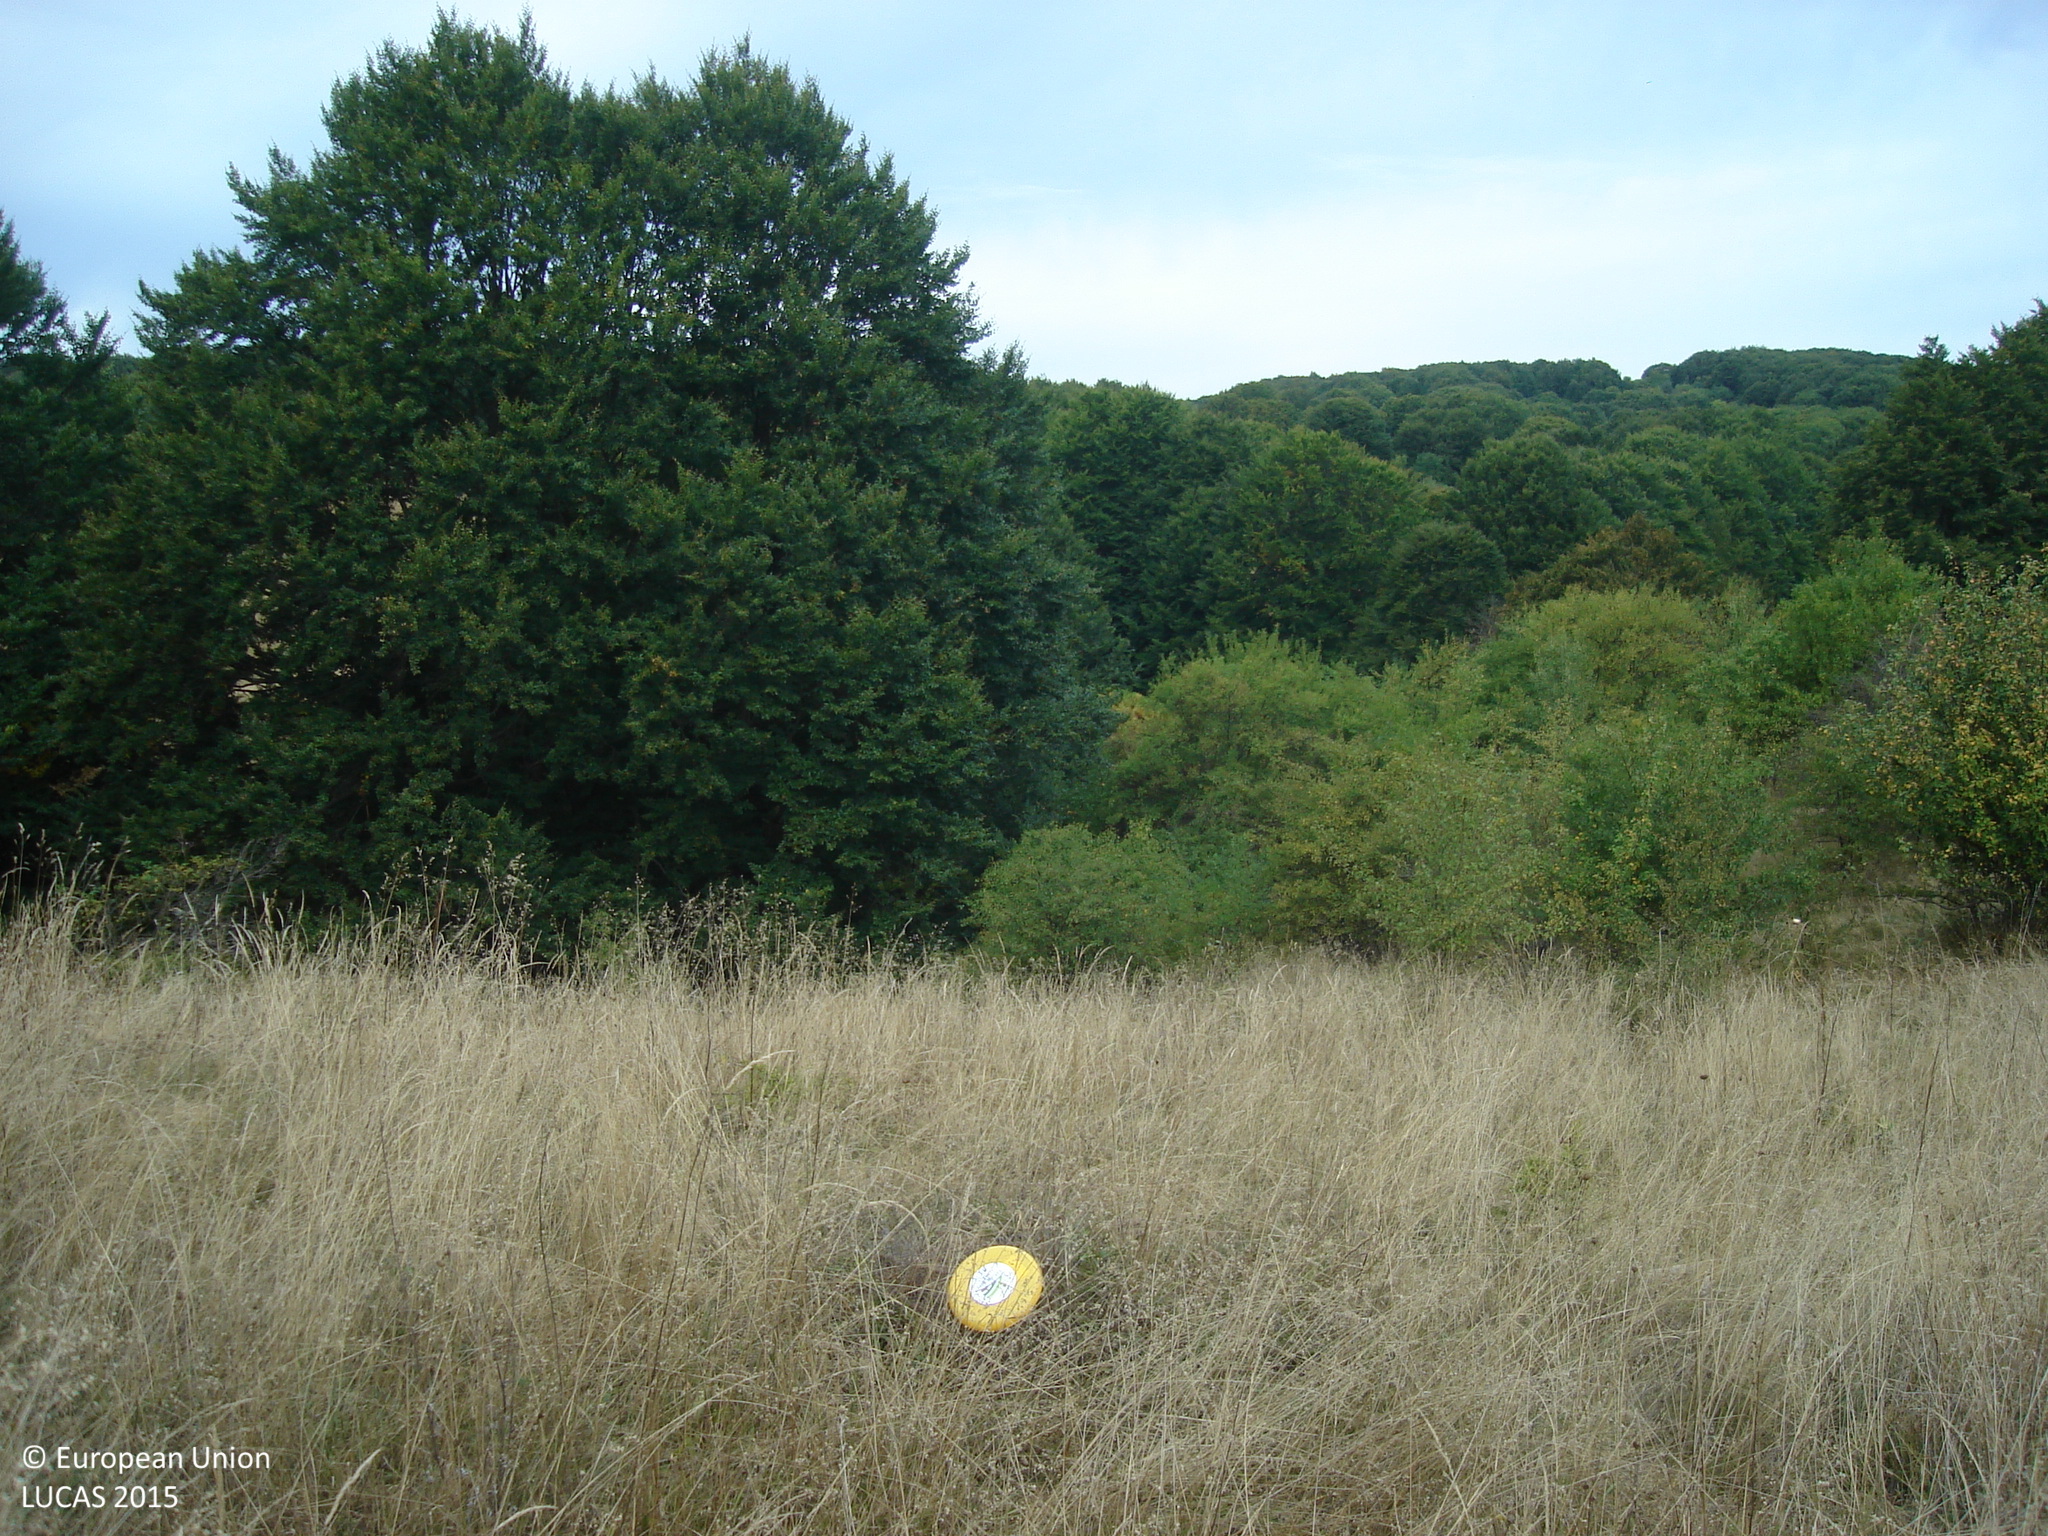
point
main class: Grassland
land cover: Grassland without tree/shrub cover
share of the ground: > 75 %
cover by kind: herbaceous plants 95 %, shrubs 5 %
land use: Agriculture (excluding fallow land and kitchen gardens)
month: September
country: BG
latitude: 42.5408
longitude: 23.8363
